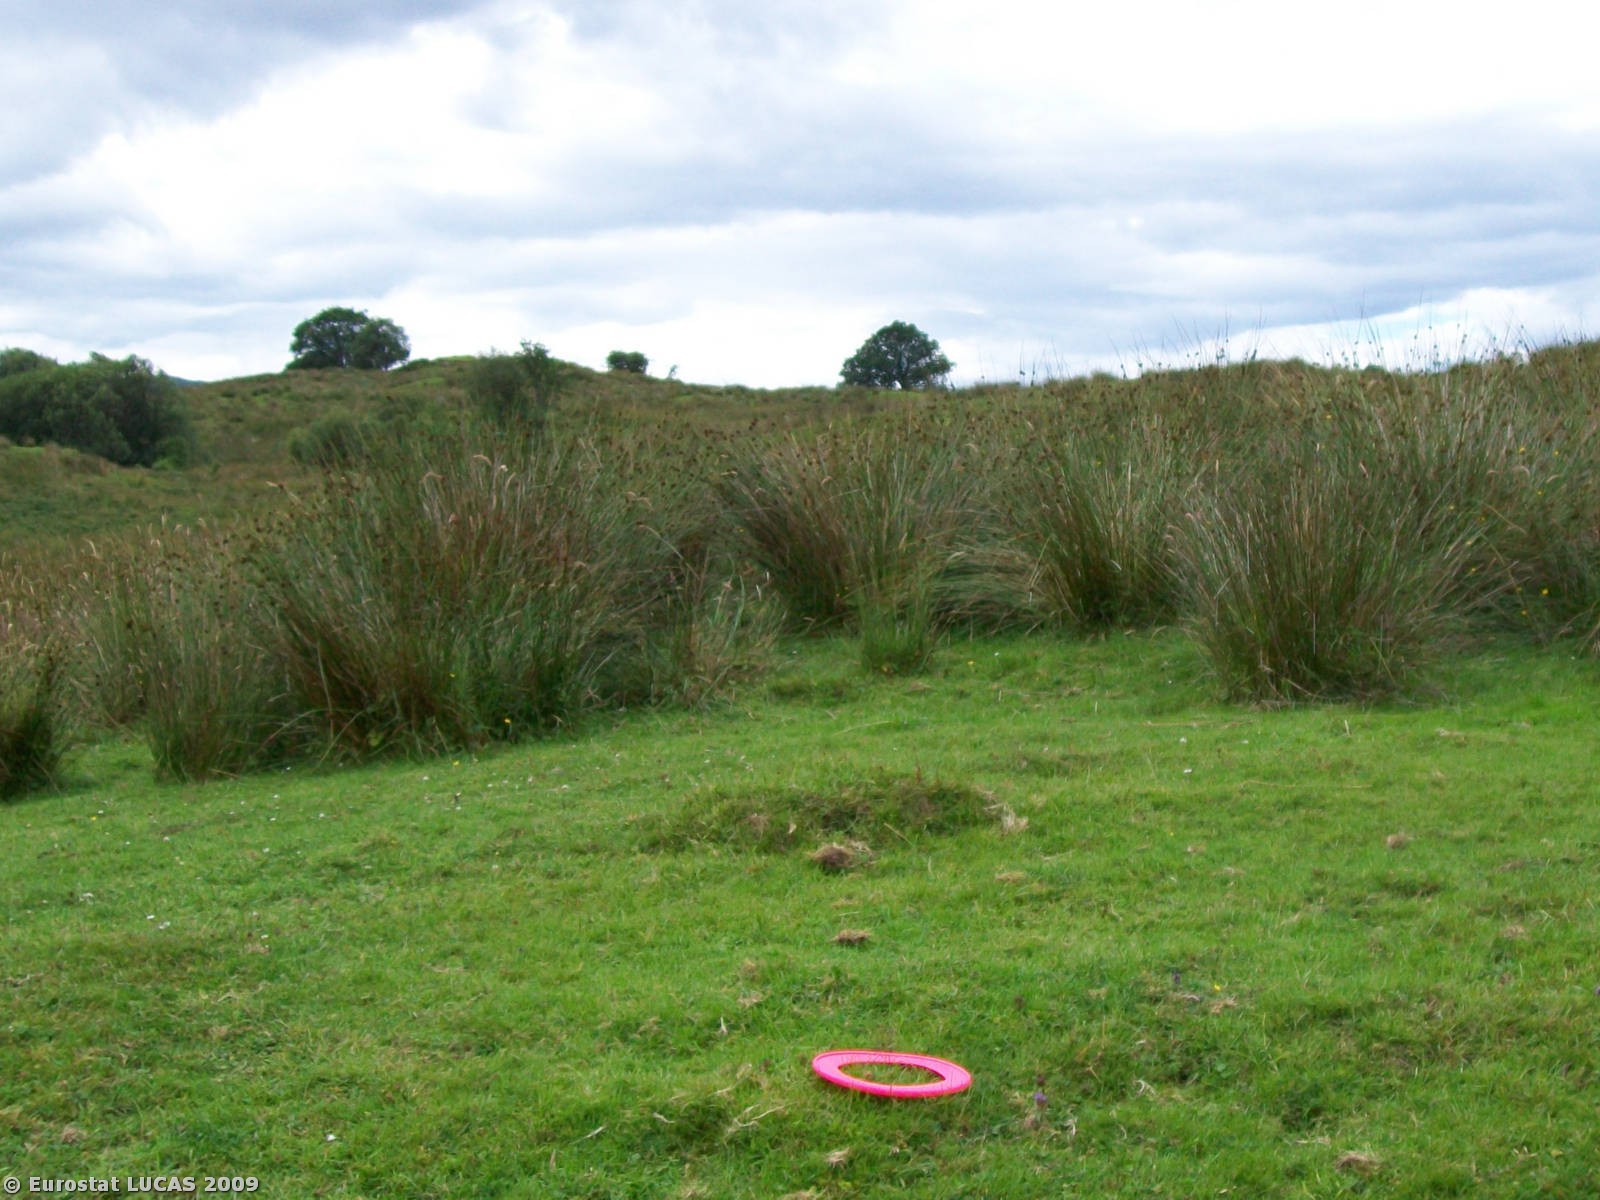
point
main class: Grassland
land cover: Grassland without tree/shrub cover
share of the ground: > 75 %
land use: Agriculture (excluding fallow land and kitchen gardens)
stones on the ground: 10 - 25 %
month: July
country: GB
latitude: 56.4250
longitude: -5.2409
